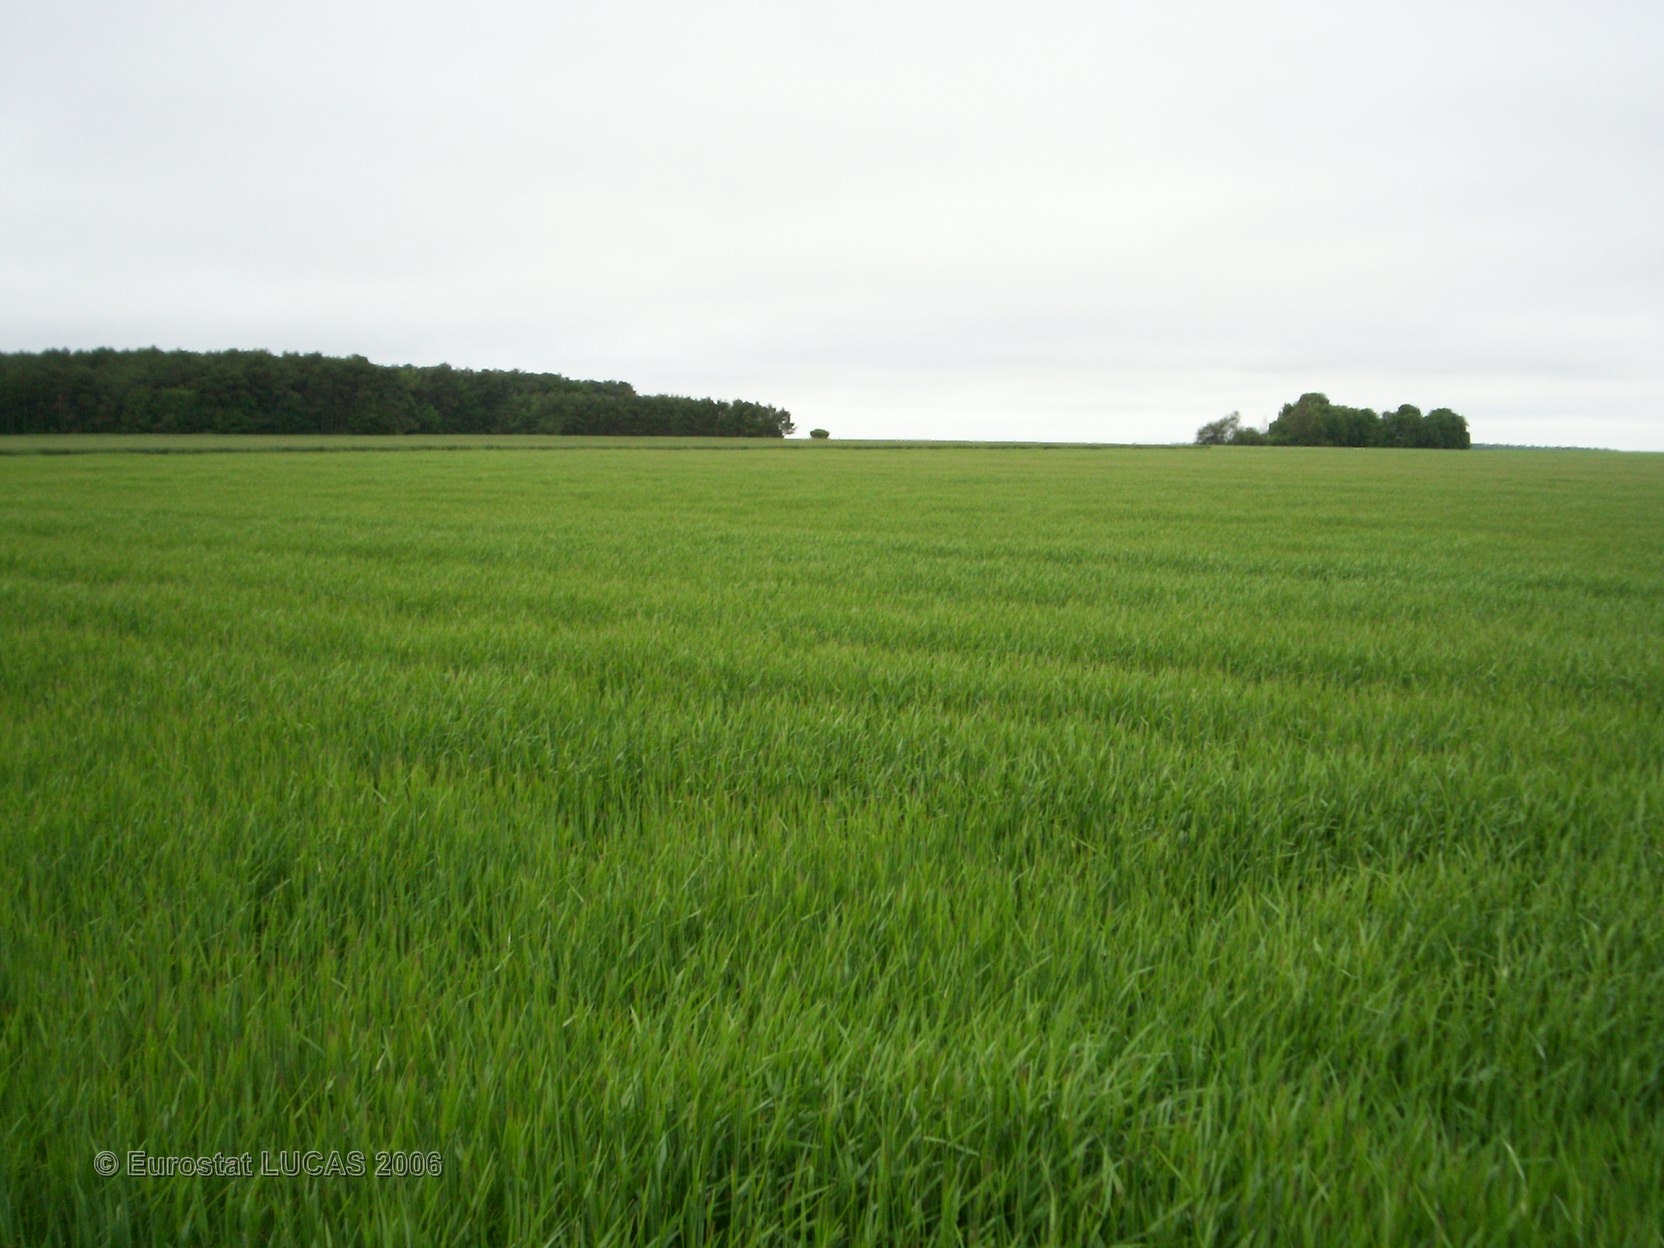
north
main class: Cropland
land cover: Triticale
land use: Agriculture (excluding fallow land and kitchen gardens)
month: May
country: FR
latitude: 47.3029
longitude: 0.8963
